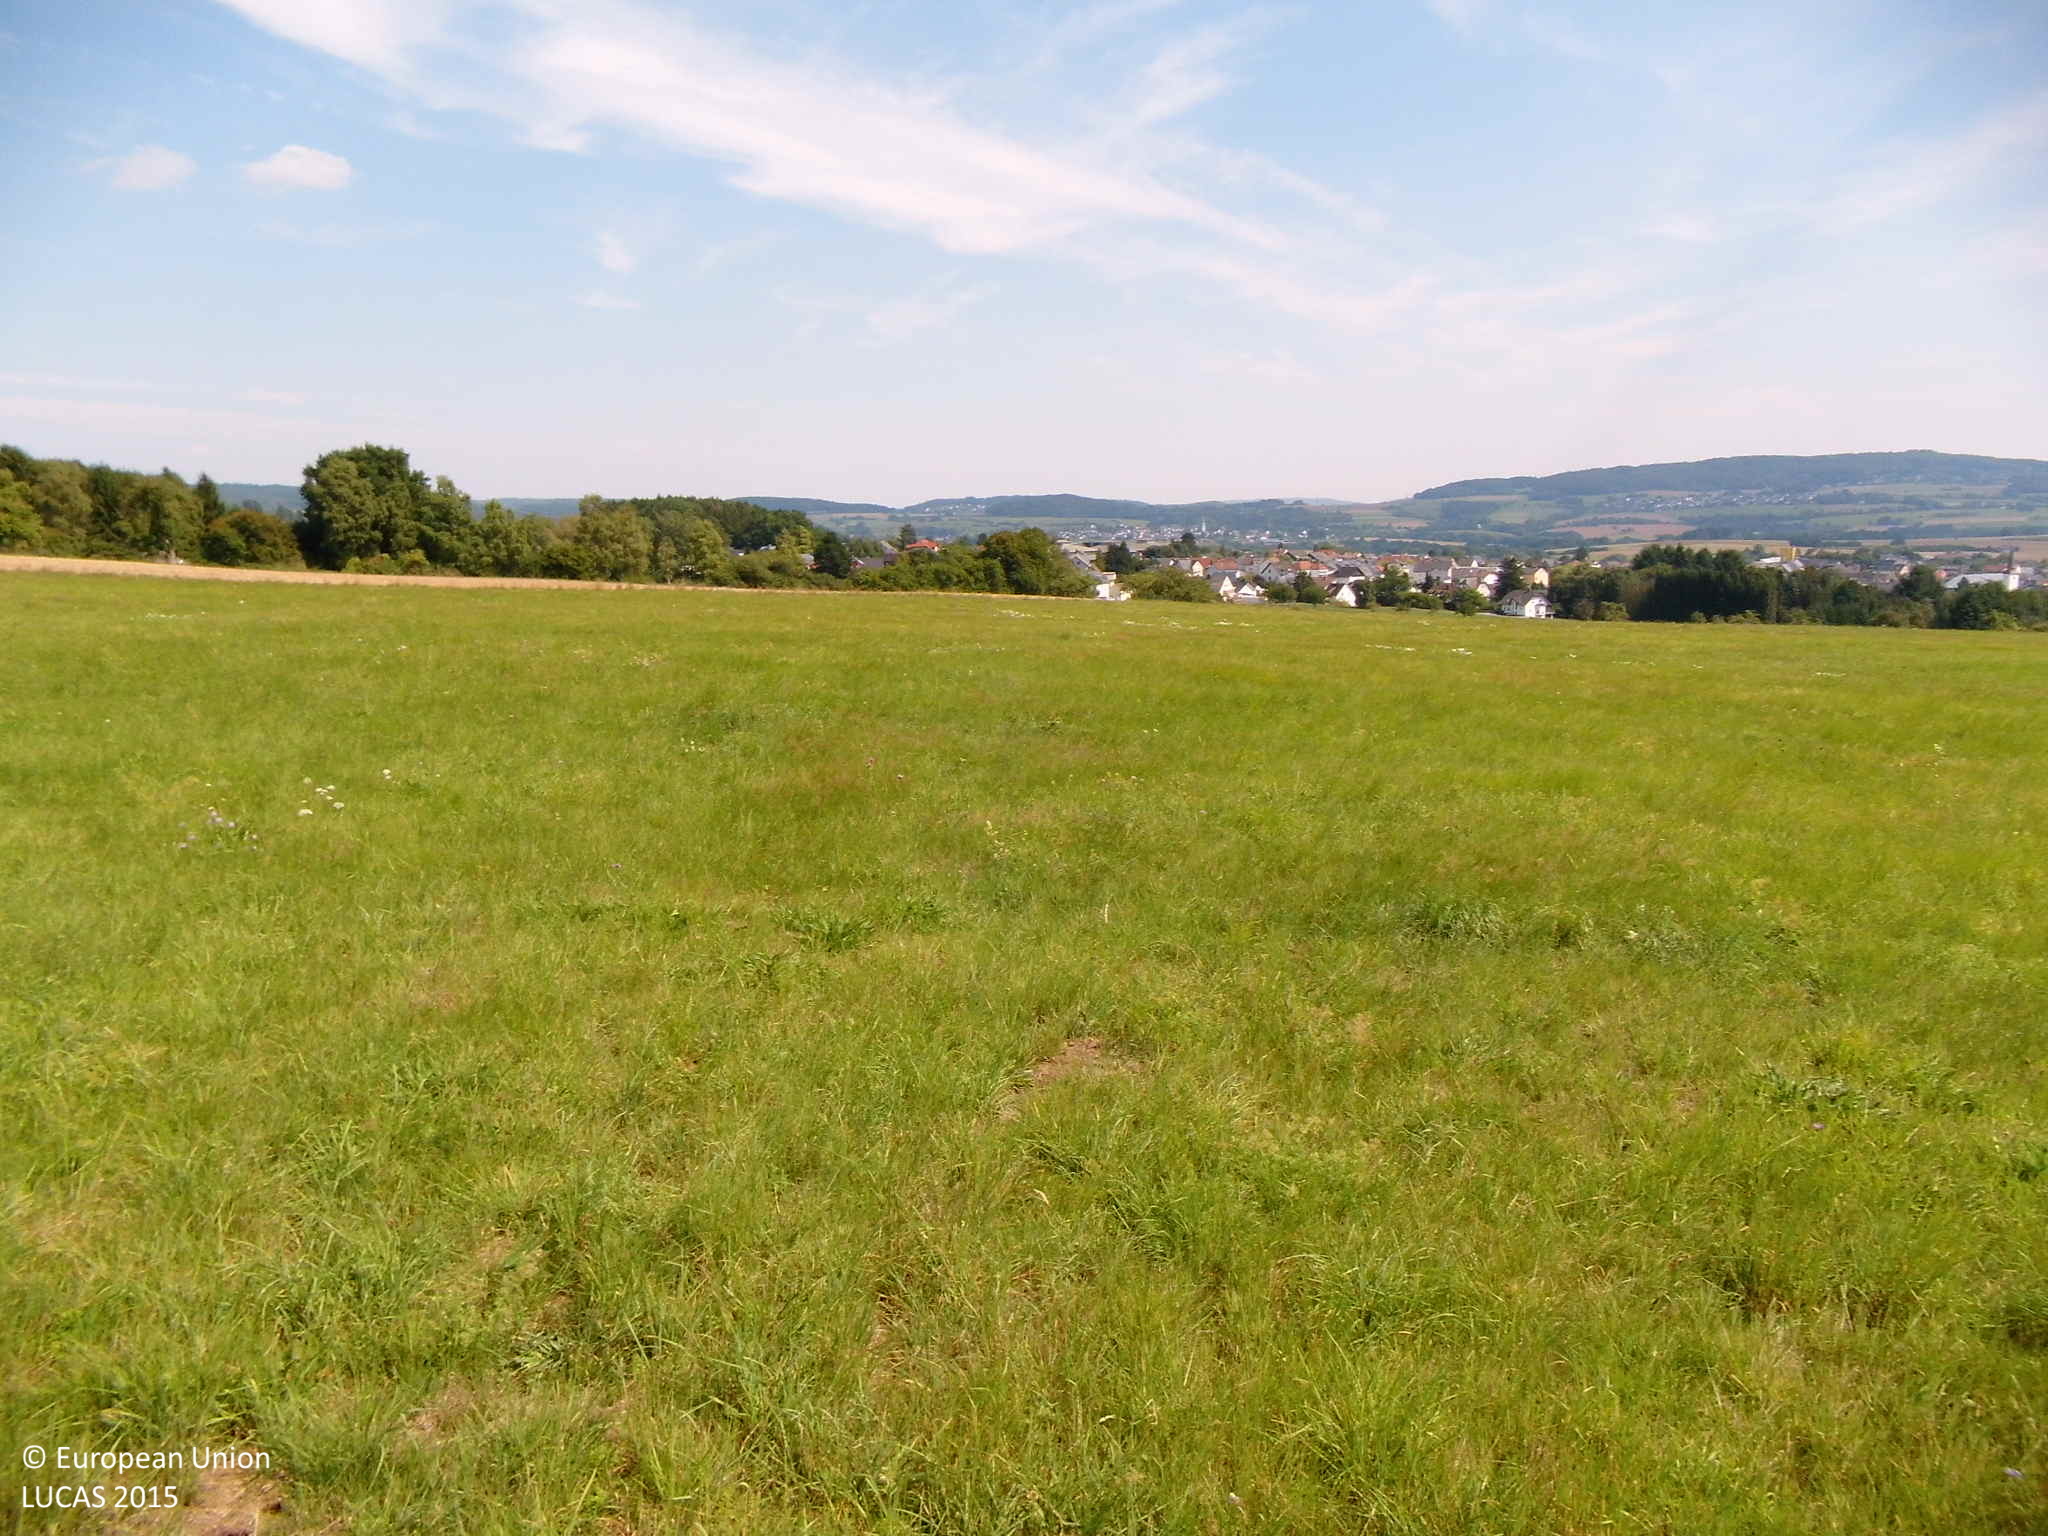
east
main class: Grassland
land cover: Grassland without tree/shrub cover
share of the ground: > 75 %
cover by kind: herbaceous plants 95 %, unconsolidated bare surface 5 %
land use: Agriculture (excluding fallow land and kitchen gardens)
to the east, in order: Grassland without tree/shrub cover; Ditches and canals; Grass margins; Barley; Grassland without tree/shrub cover; Ditches and canals; Shruby margins; Tracks; Grassland without tree/shrub cover
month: August
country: DE
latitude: 50.5087
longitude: 8.0121
